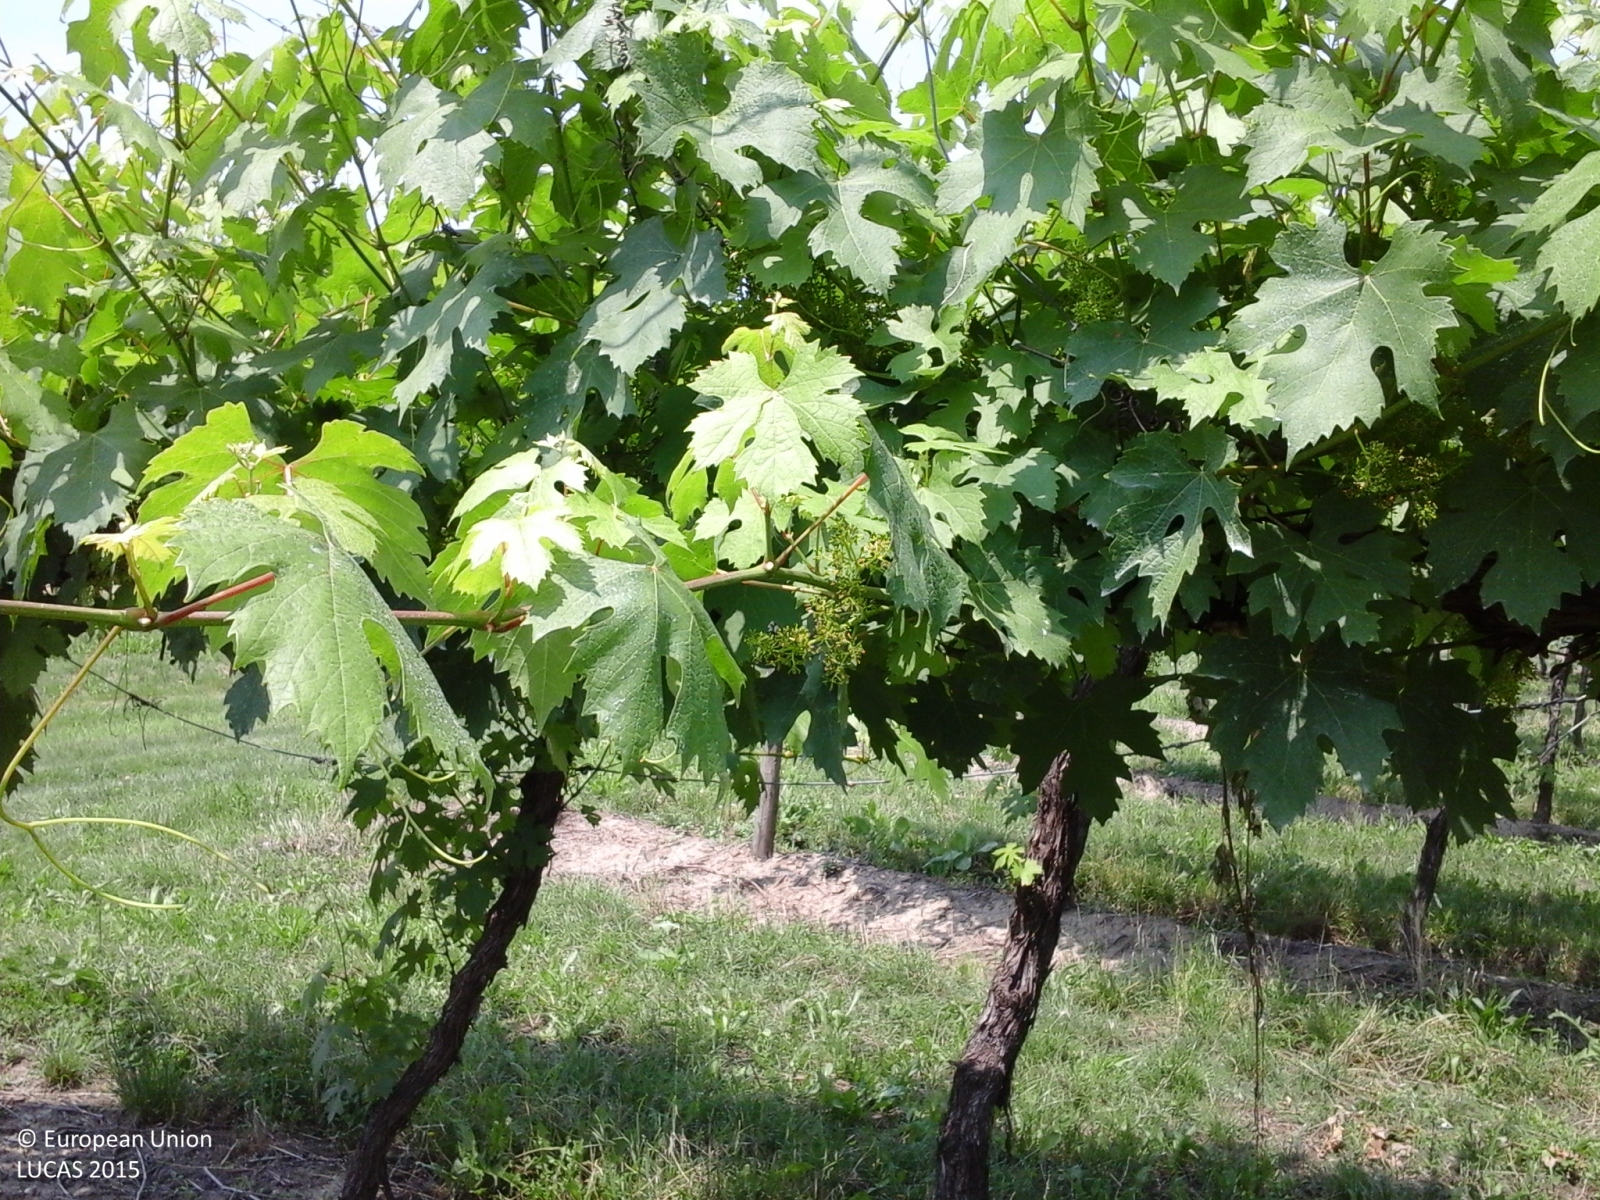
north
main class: Cropland
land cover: Vineyards
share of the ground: 50 - 75 %
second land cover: Grassland without tree/shrub cover
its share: > 75 %
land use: Agriculture (excluding fallow land and kitchen gardens)
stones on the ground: < 10 %
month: May
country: IT
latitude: 44.7987
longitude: 10.7443
